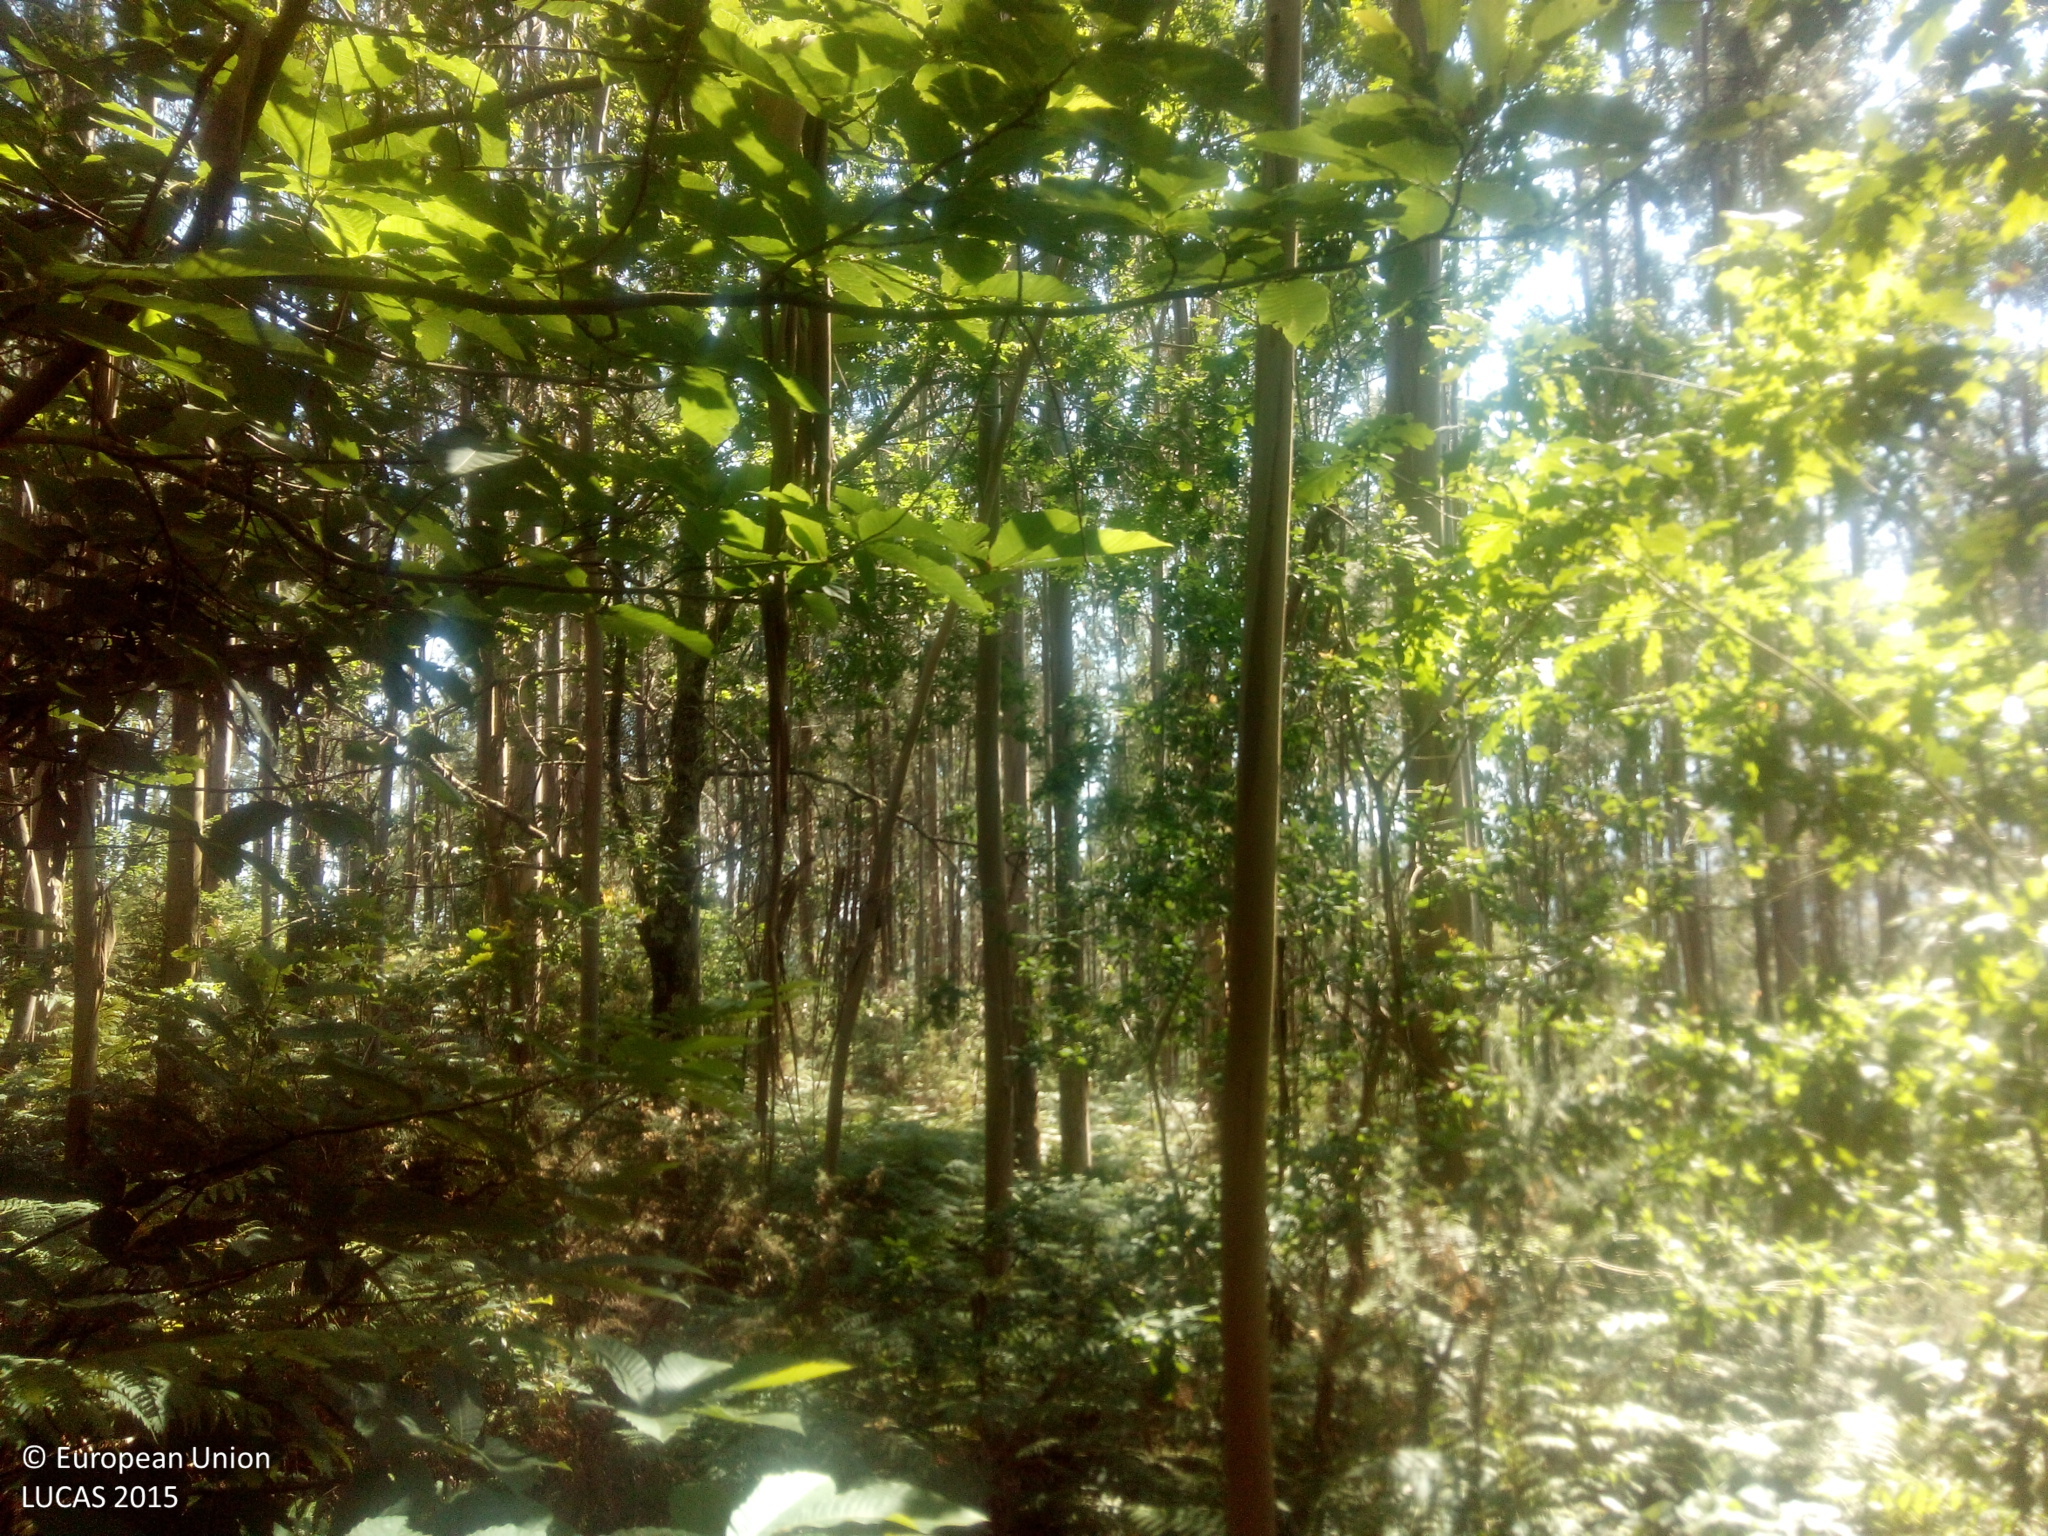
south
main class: Woodland
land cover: Broadleaved woodland
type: exotic forest
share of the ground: > 75 %
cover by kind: broadleaved forest trees 100 %
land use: Forestry
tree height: > 5 m
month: June
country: ES
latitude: 42.1738
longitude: -8.2819
